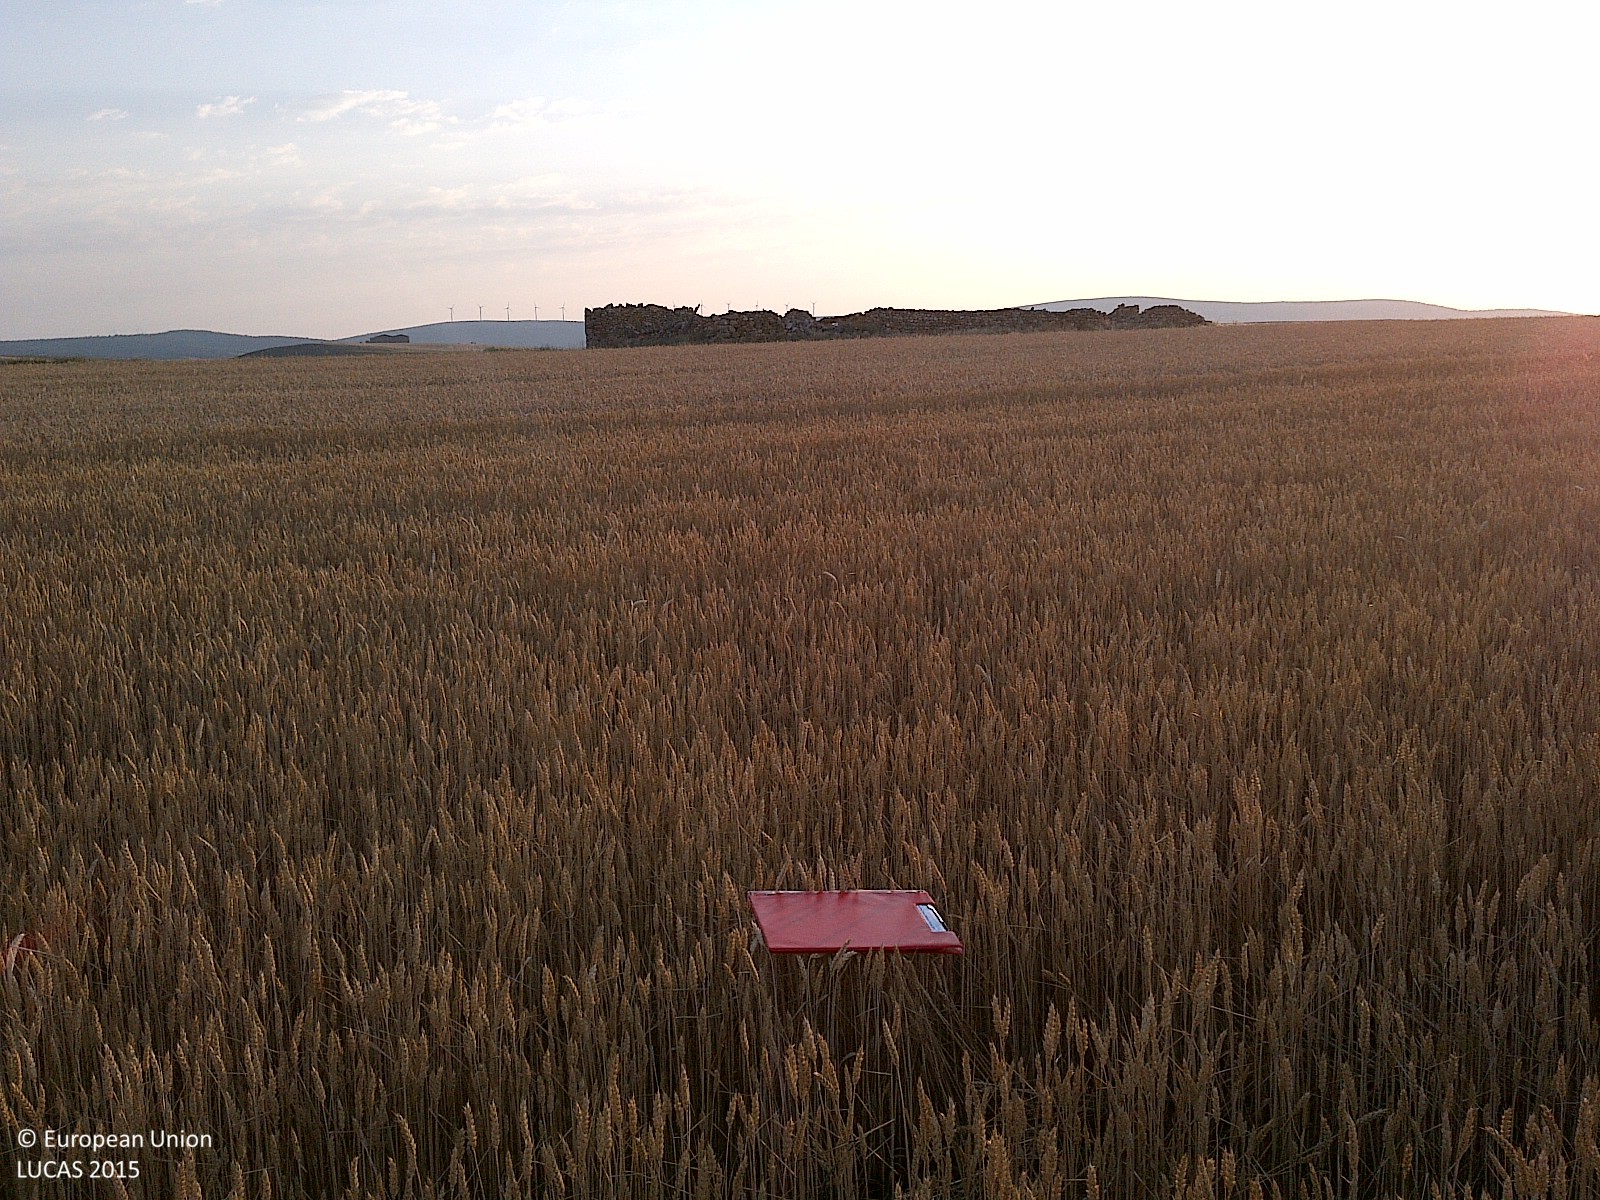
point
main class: Cropland
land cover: Common wheat
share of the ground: > 75 %
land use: Agriculture (excluding fallow land and kitchen gardens)
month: June
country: ES
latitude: 41.6910
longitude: -2.2296
